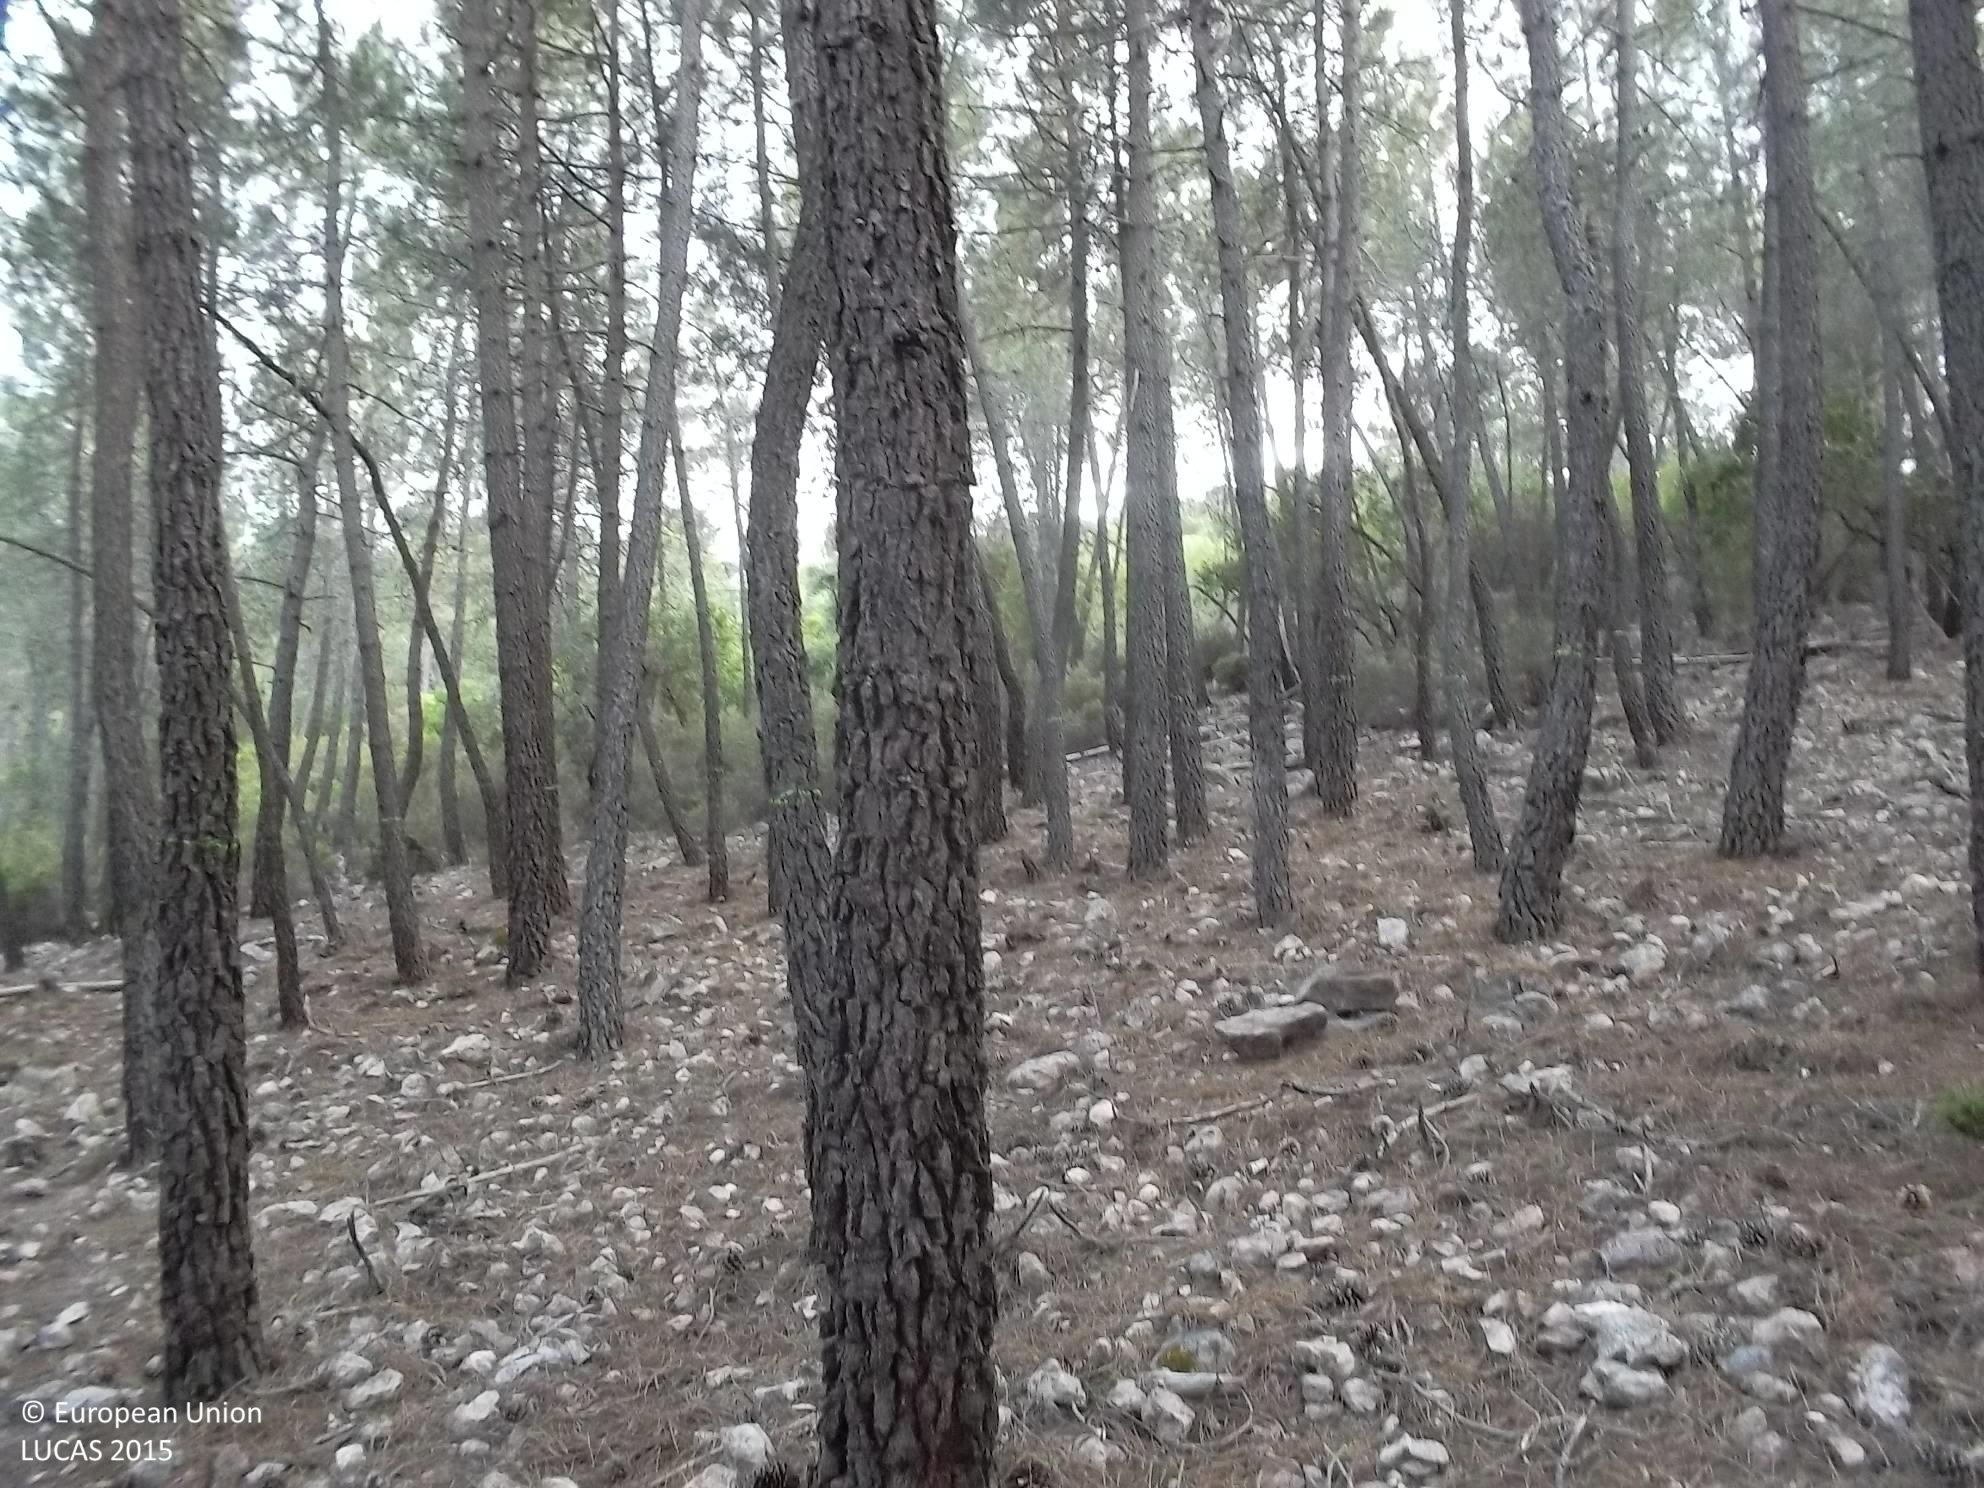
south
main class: Woodland
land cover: Pine dominated coniferous woodland
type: coniferous forest of the mediterranean region
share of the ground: 50 - 75 %
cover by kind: coniferous forest trees 90 %, shrubs 10 %
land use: Forestry
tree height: > 5 m
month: June
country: ES
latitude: 39.2147
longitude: -4.8969
